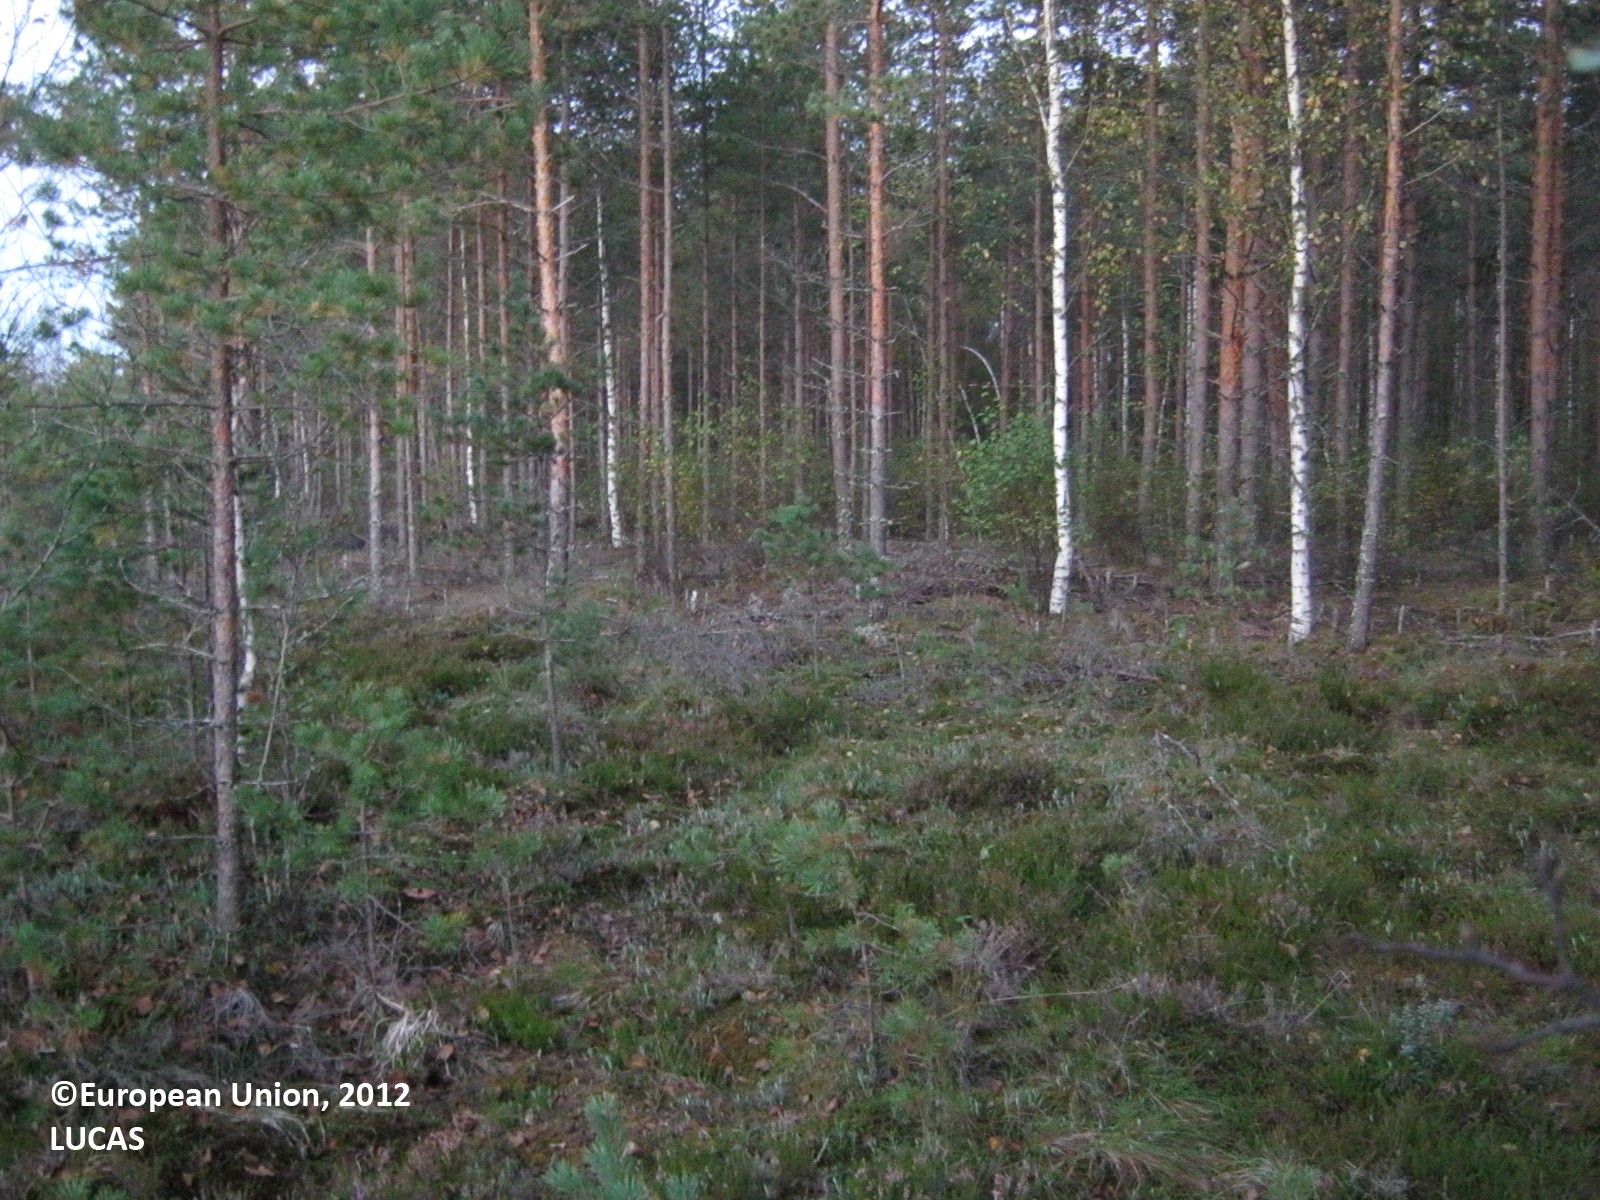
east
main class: Woodland
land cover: Pine dominated mixed woodland
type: boreal forest
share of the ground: 50 - 75 %
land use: Forestry
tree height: > 5 m
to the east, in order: Pine dominated mixed woodland; Ditches and canals; Pine dominated mixed woodland; Ditches and canals; Pine dominated mixed woodland; Ditches and canals; Pine dominated mixed woodland; Ditches and canals; Pine dominated mixed woodland; Ditches and canals; Pine dominated mixed woodland; Ditches and canals; Pine dominated mixed woodland
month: September
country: FI
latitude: 60.8405
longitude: 27.8774
